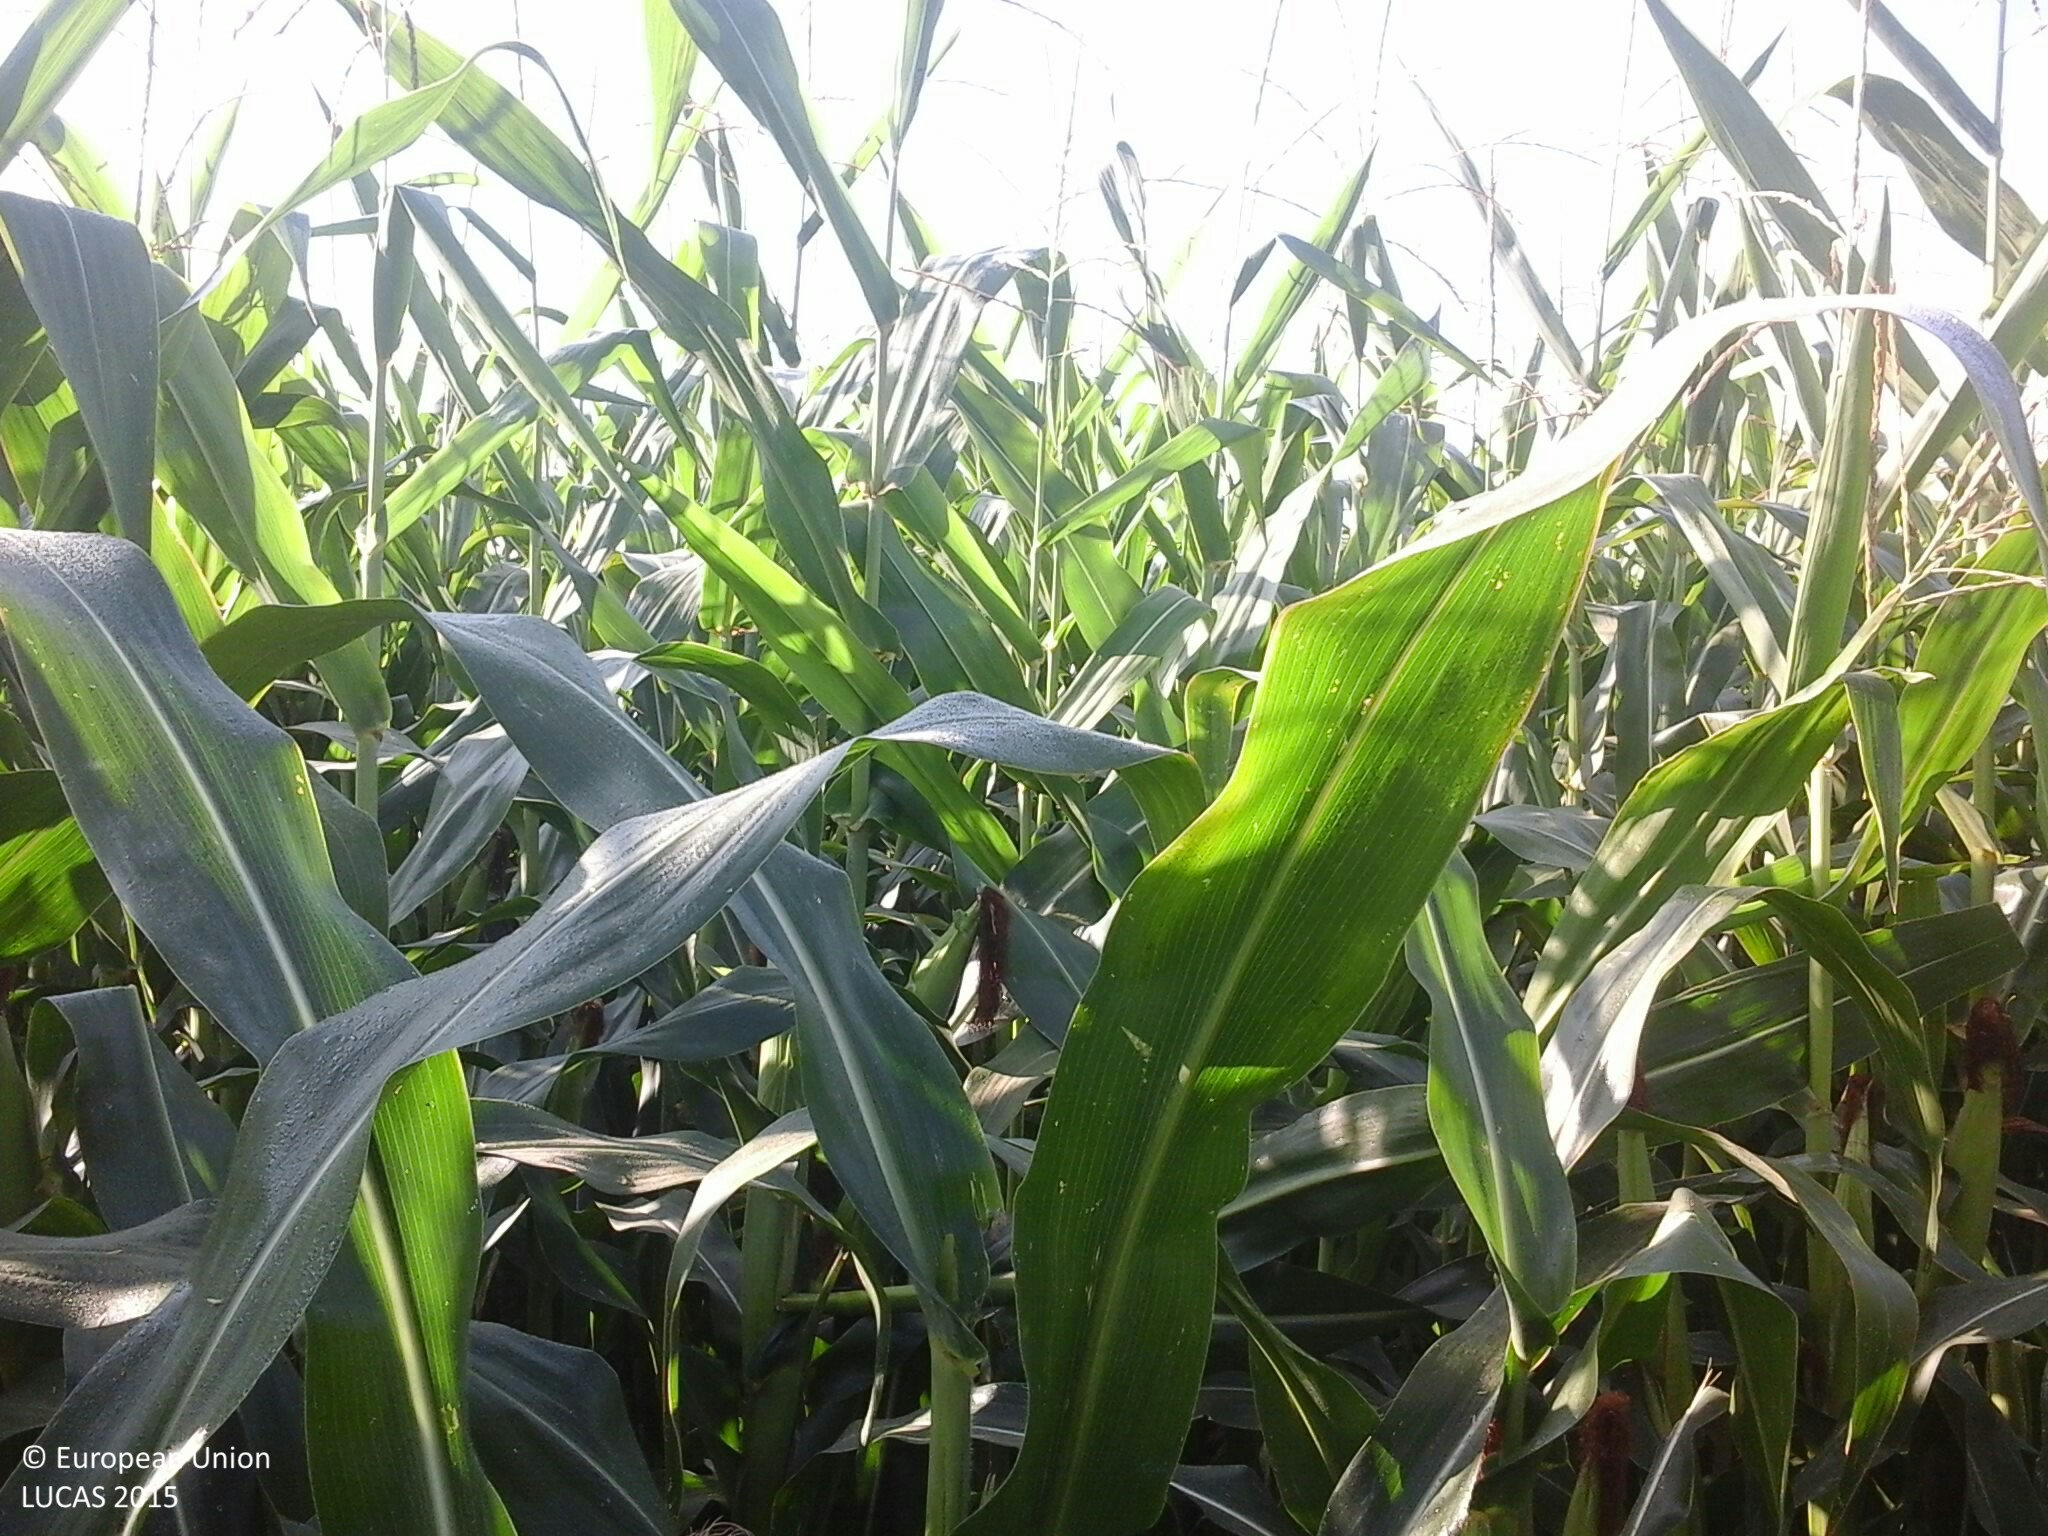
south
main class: Cropland
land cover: Maize
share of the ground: > 75 %
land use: Agriculture (excluding fallow land and kitchen gardens)
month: July
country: HU
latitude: 48.2003
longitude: 22.3421
